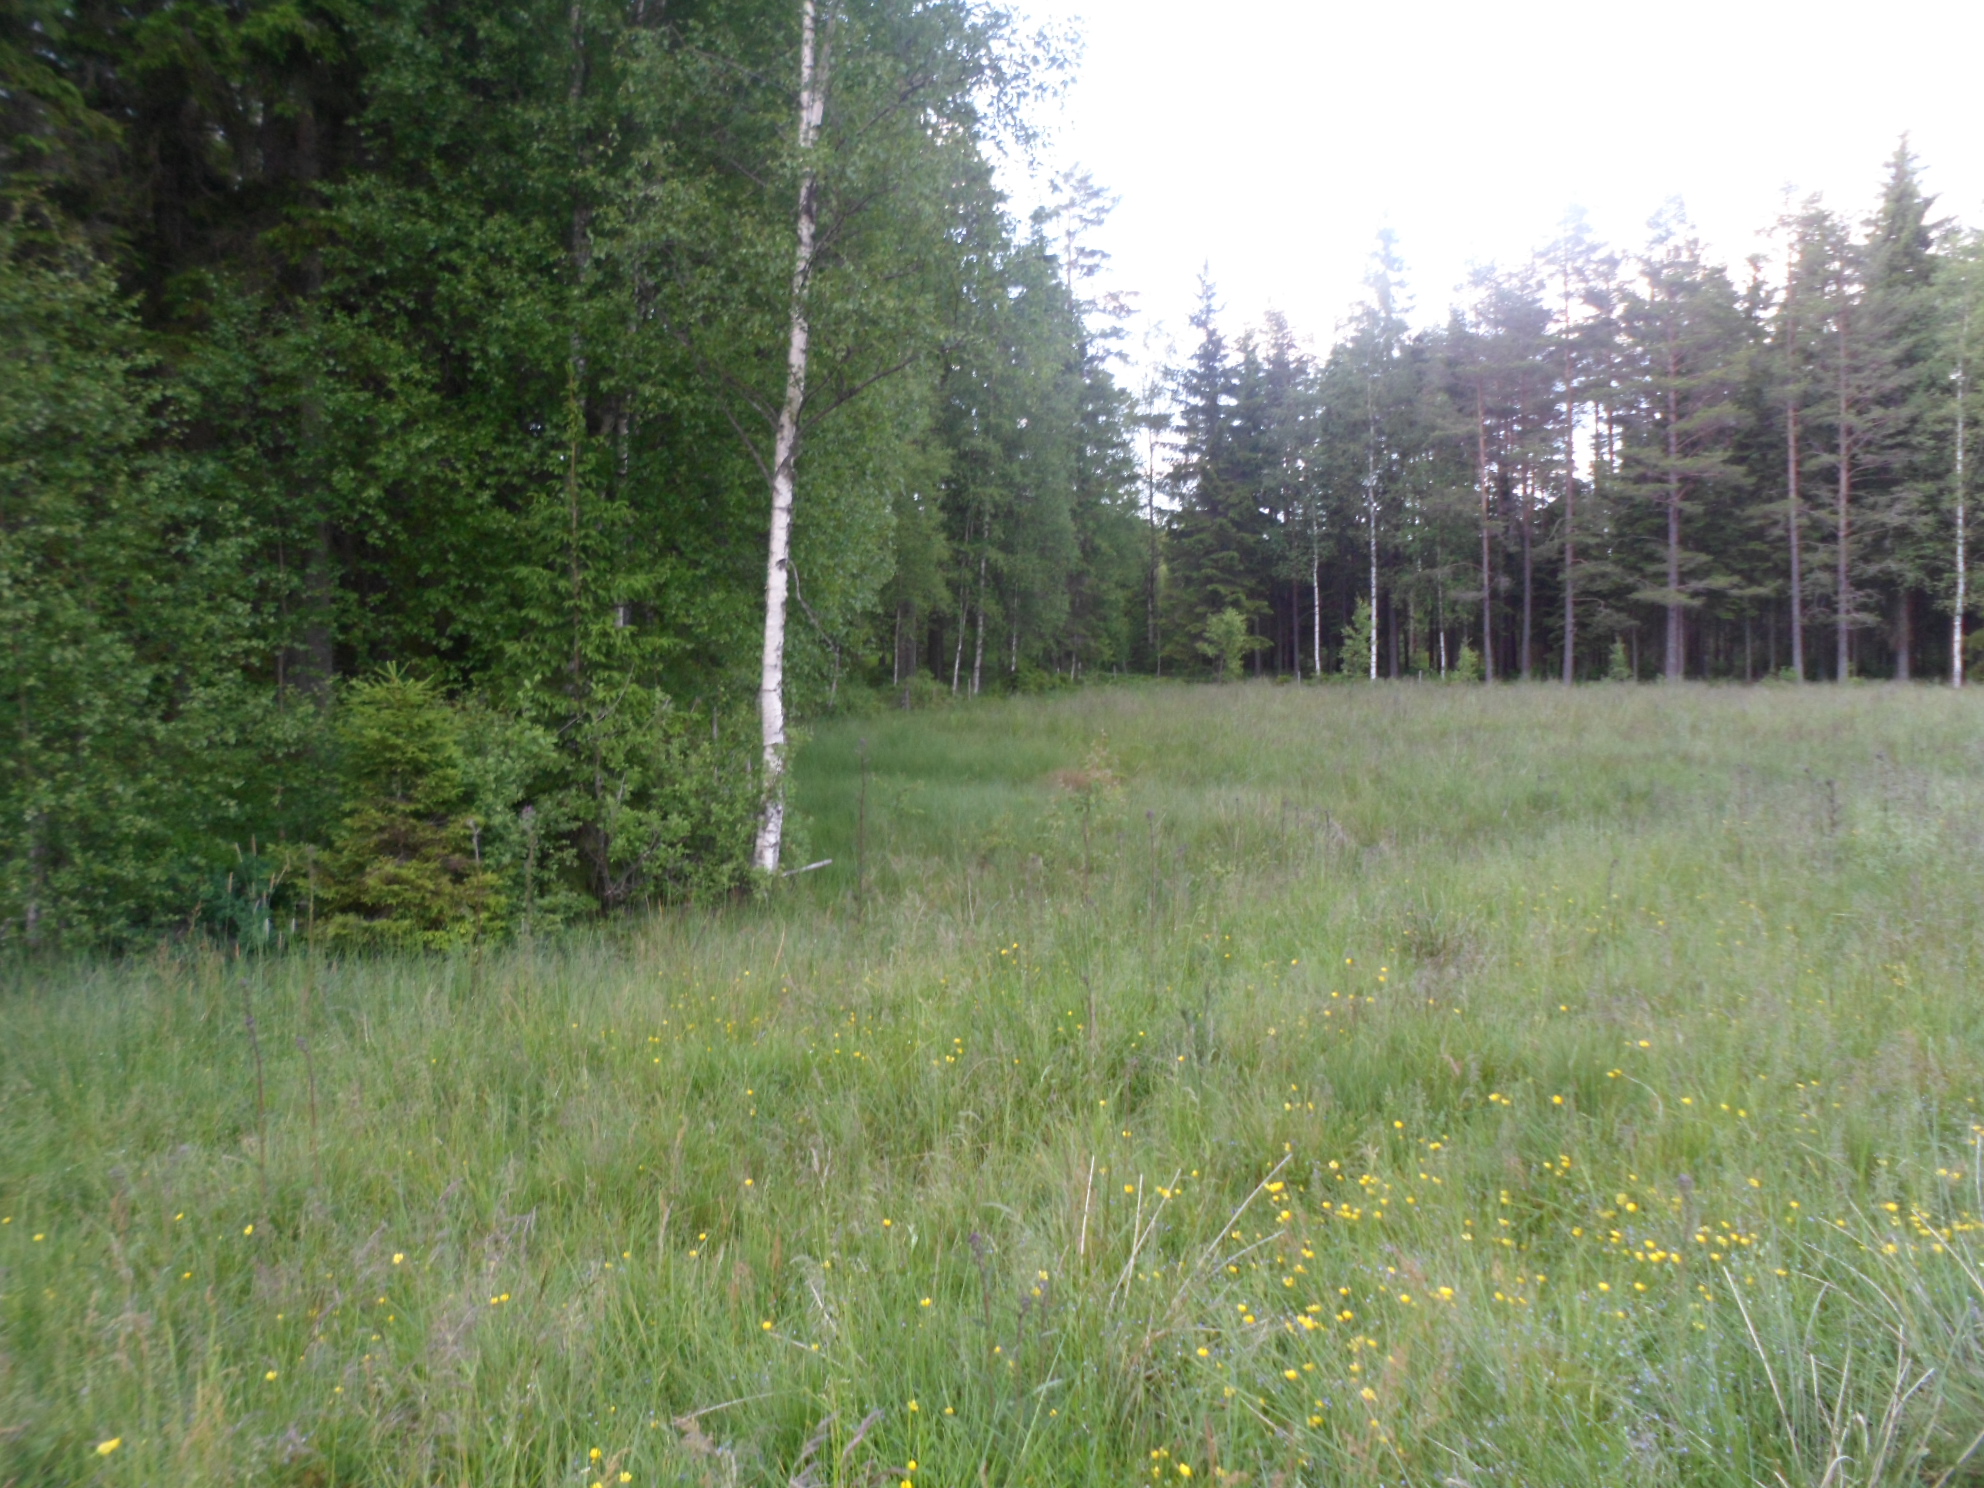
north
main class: Grassland
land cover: Grassland without tree/shrub cover
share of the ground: > 75 %
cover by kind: herbaceous plants 100 %
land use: Agriculture (excluding fallow land and kitchen gardens)
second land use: Amenities, museums, leisure
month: July
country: SE
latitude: 57.5713
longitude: 14.3928
